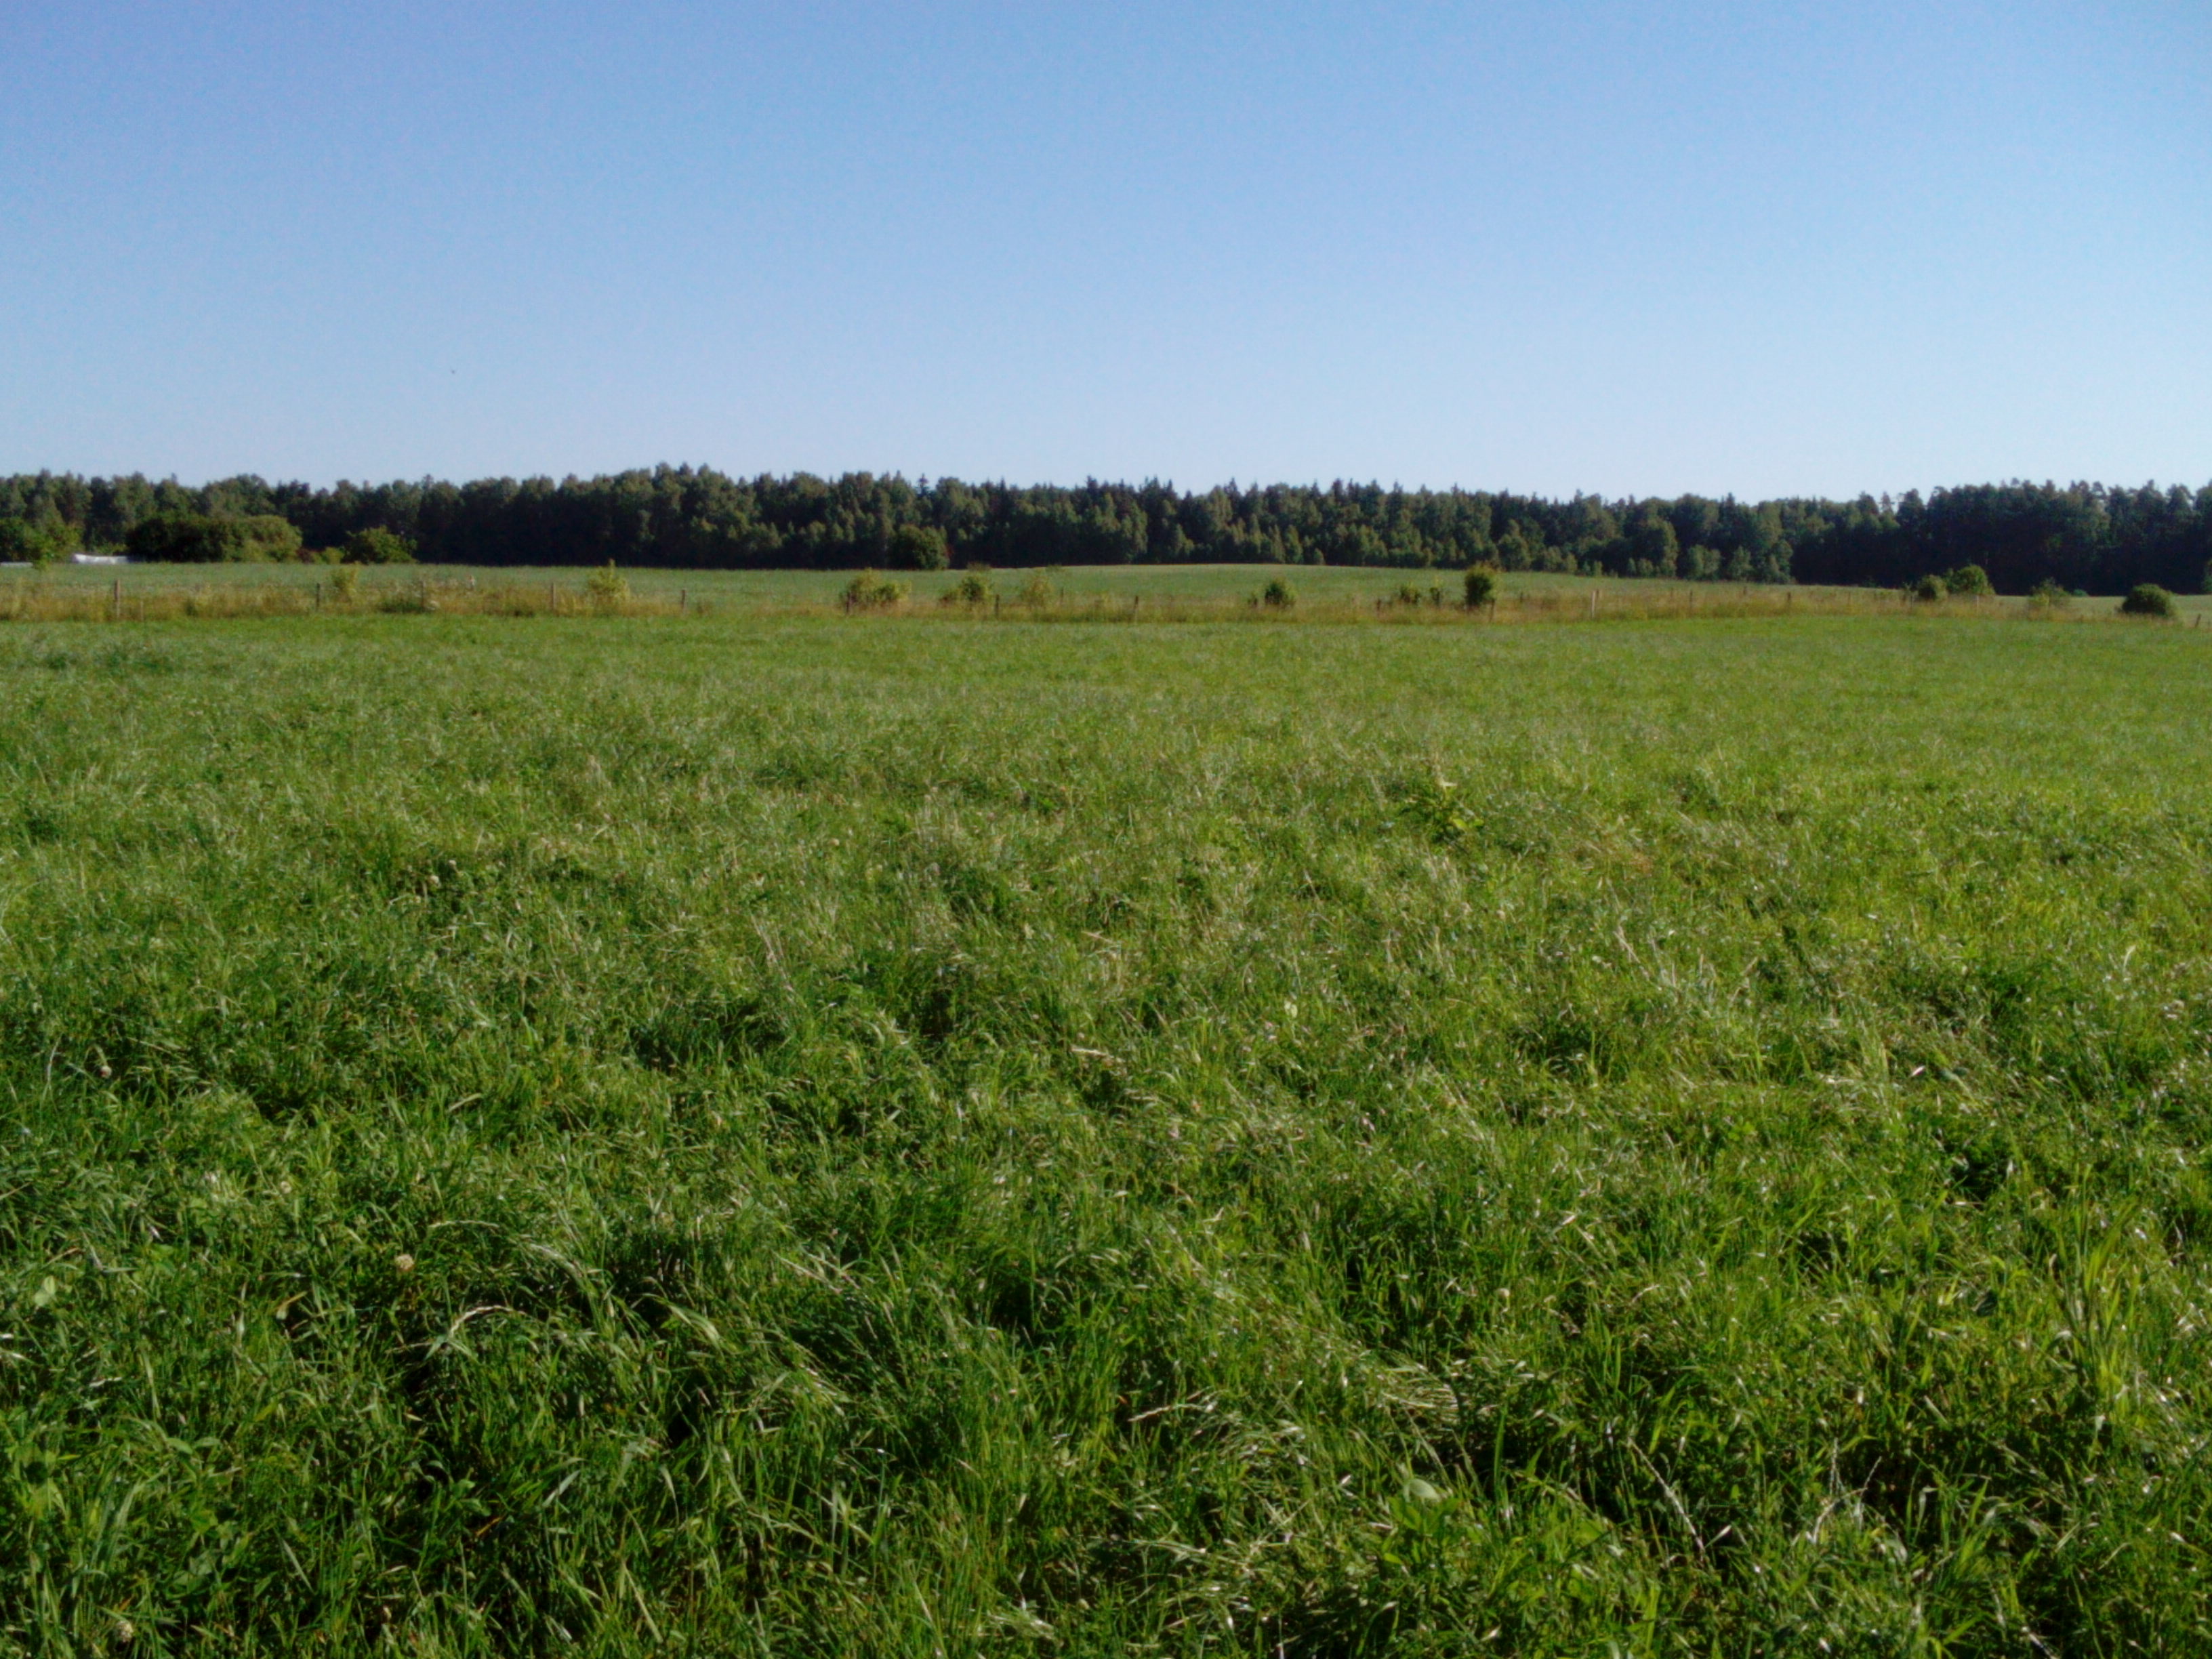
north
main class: Grassland
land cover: Grassland without tree/shrub cover
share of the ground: > 75 %
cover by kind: herbaceous plants 100 %
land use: Agriculture (excluding fallow land and kitchen gardens)
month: July
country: LV
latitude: 56.4465
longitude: 22.1375
